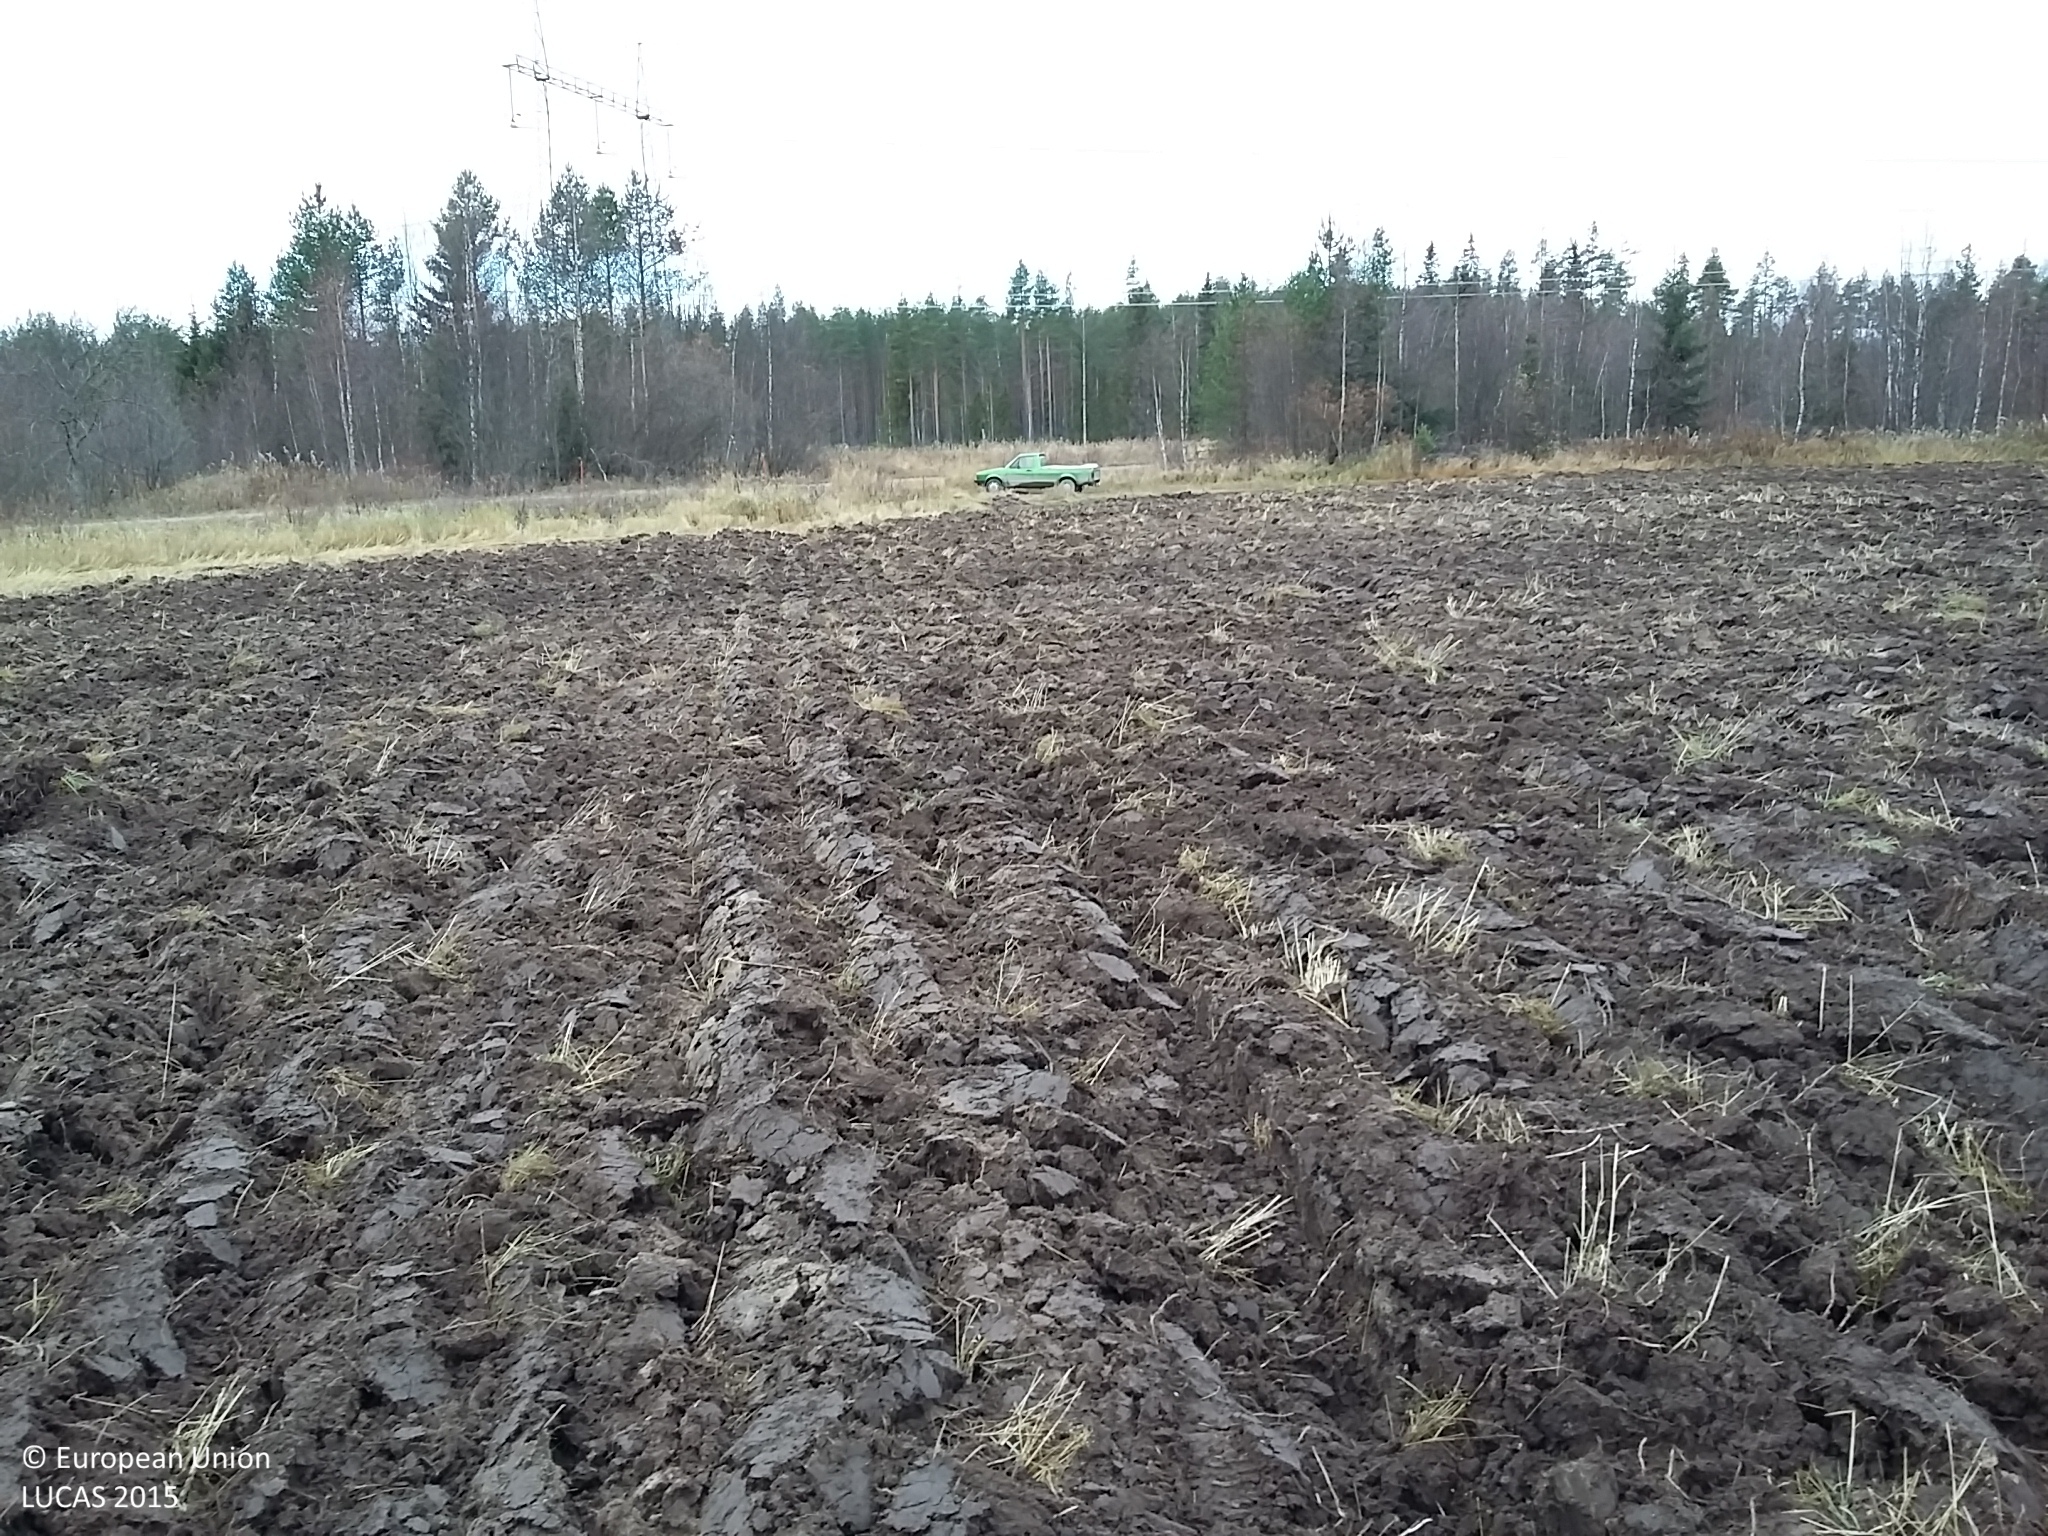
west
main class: Cropland
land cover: Oats
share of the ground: < 10 %
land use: Agriculture (excluding fallow land and kitchen gardens)
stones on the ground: < 10 %
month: October
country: FI
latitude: 64.6844
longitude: 25.4930
